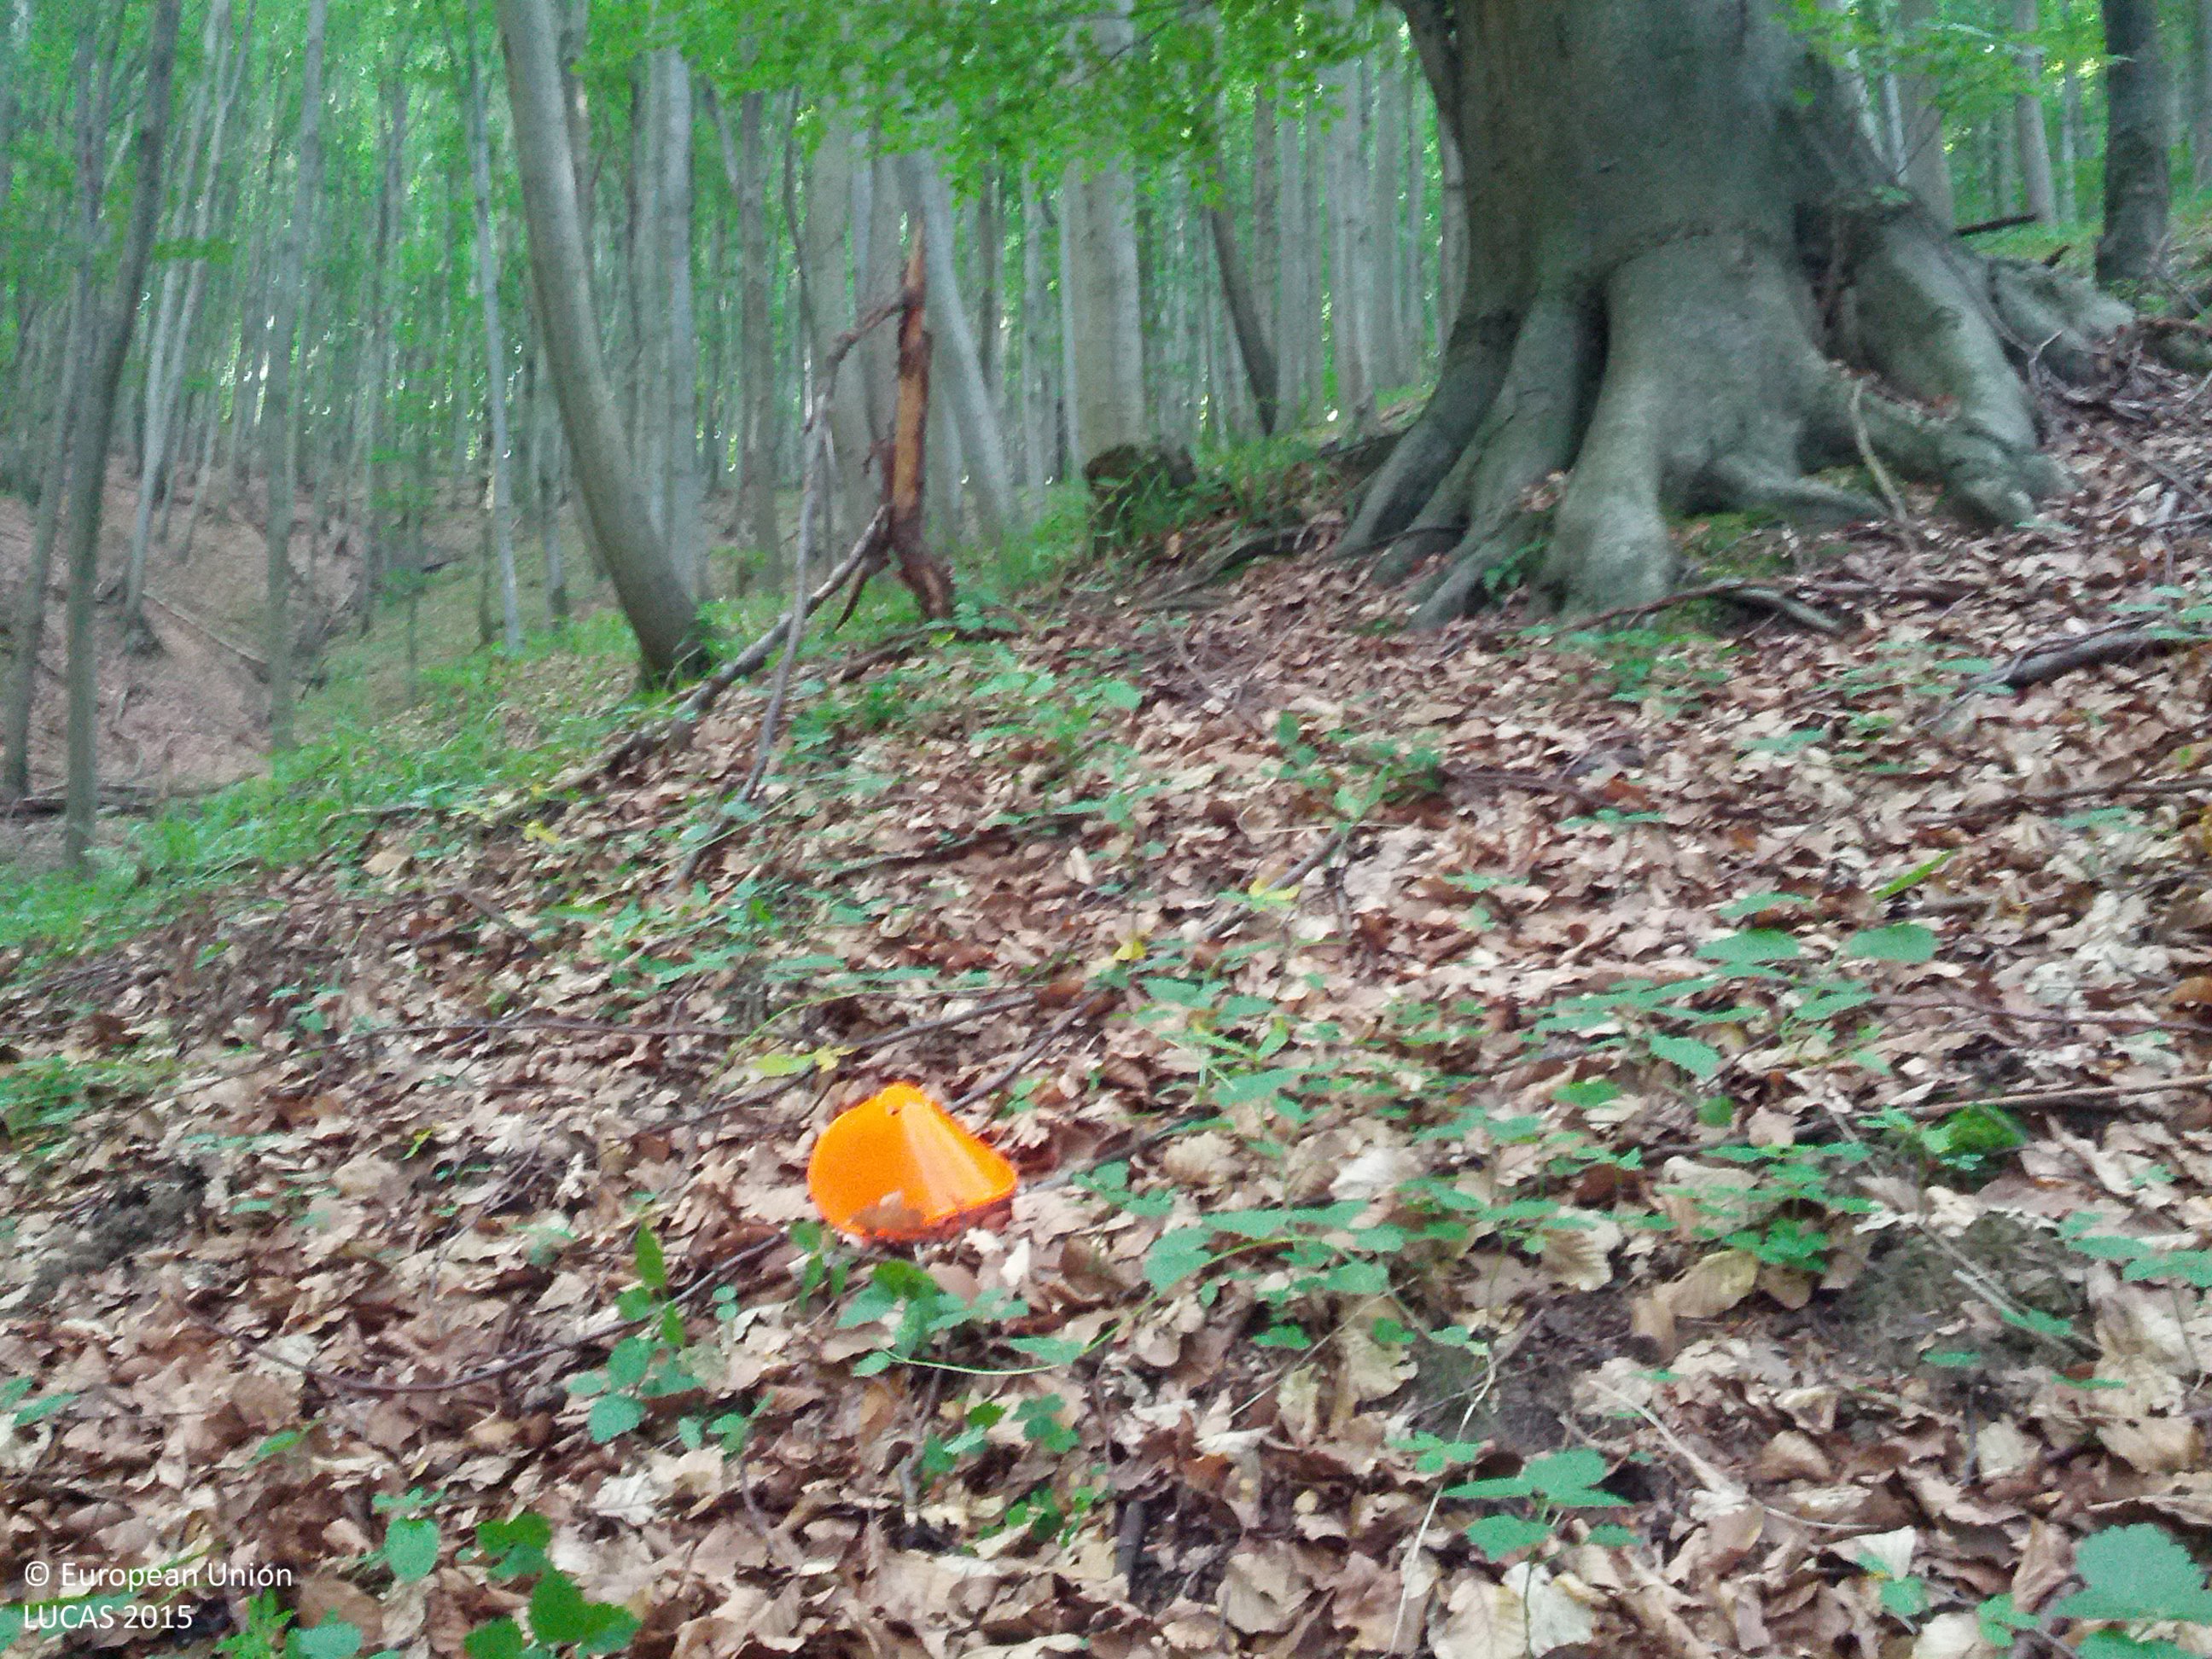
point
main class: Woodland
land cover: Broadleaved woodland
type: beech forest
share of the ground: > 75 %
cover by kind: broadleaved forest trees 95 %, herbaceous plants 5 %
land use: Forestry
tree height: > 5 m
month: May
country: AT
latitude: 48.2632
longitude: 16.2418
